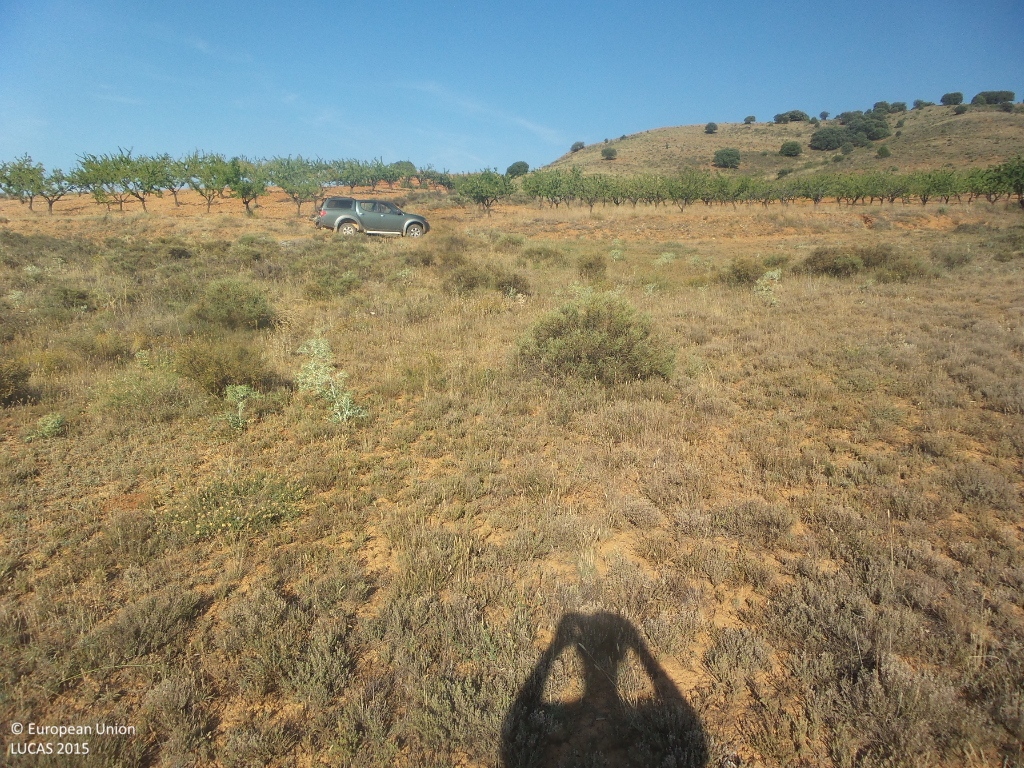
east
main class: Shrubland
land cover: Shrubland without tree cover
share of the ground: 50 - 75 %
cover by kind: shrubs 60 %, unconsolidated bare surface 30 %, herbaceous plants 10 %
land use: Semi-natural and natural areas not in use
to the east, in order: Shrubland without tree cover; Tracks; Grass margins; Nuts trees; Shrubland without tree cover; Nuts trees; Shrubland without tree cover; Shrubland with sparse tree cover
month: July
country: ES
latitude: 41.2743
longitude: -1.9053
